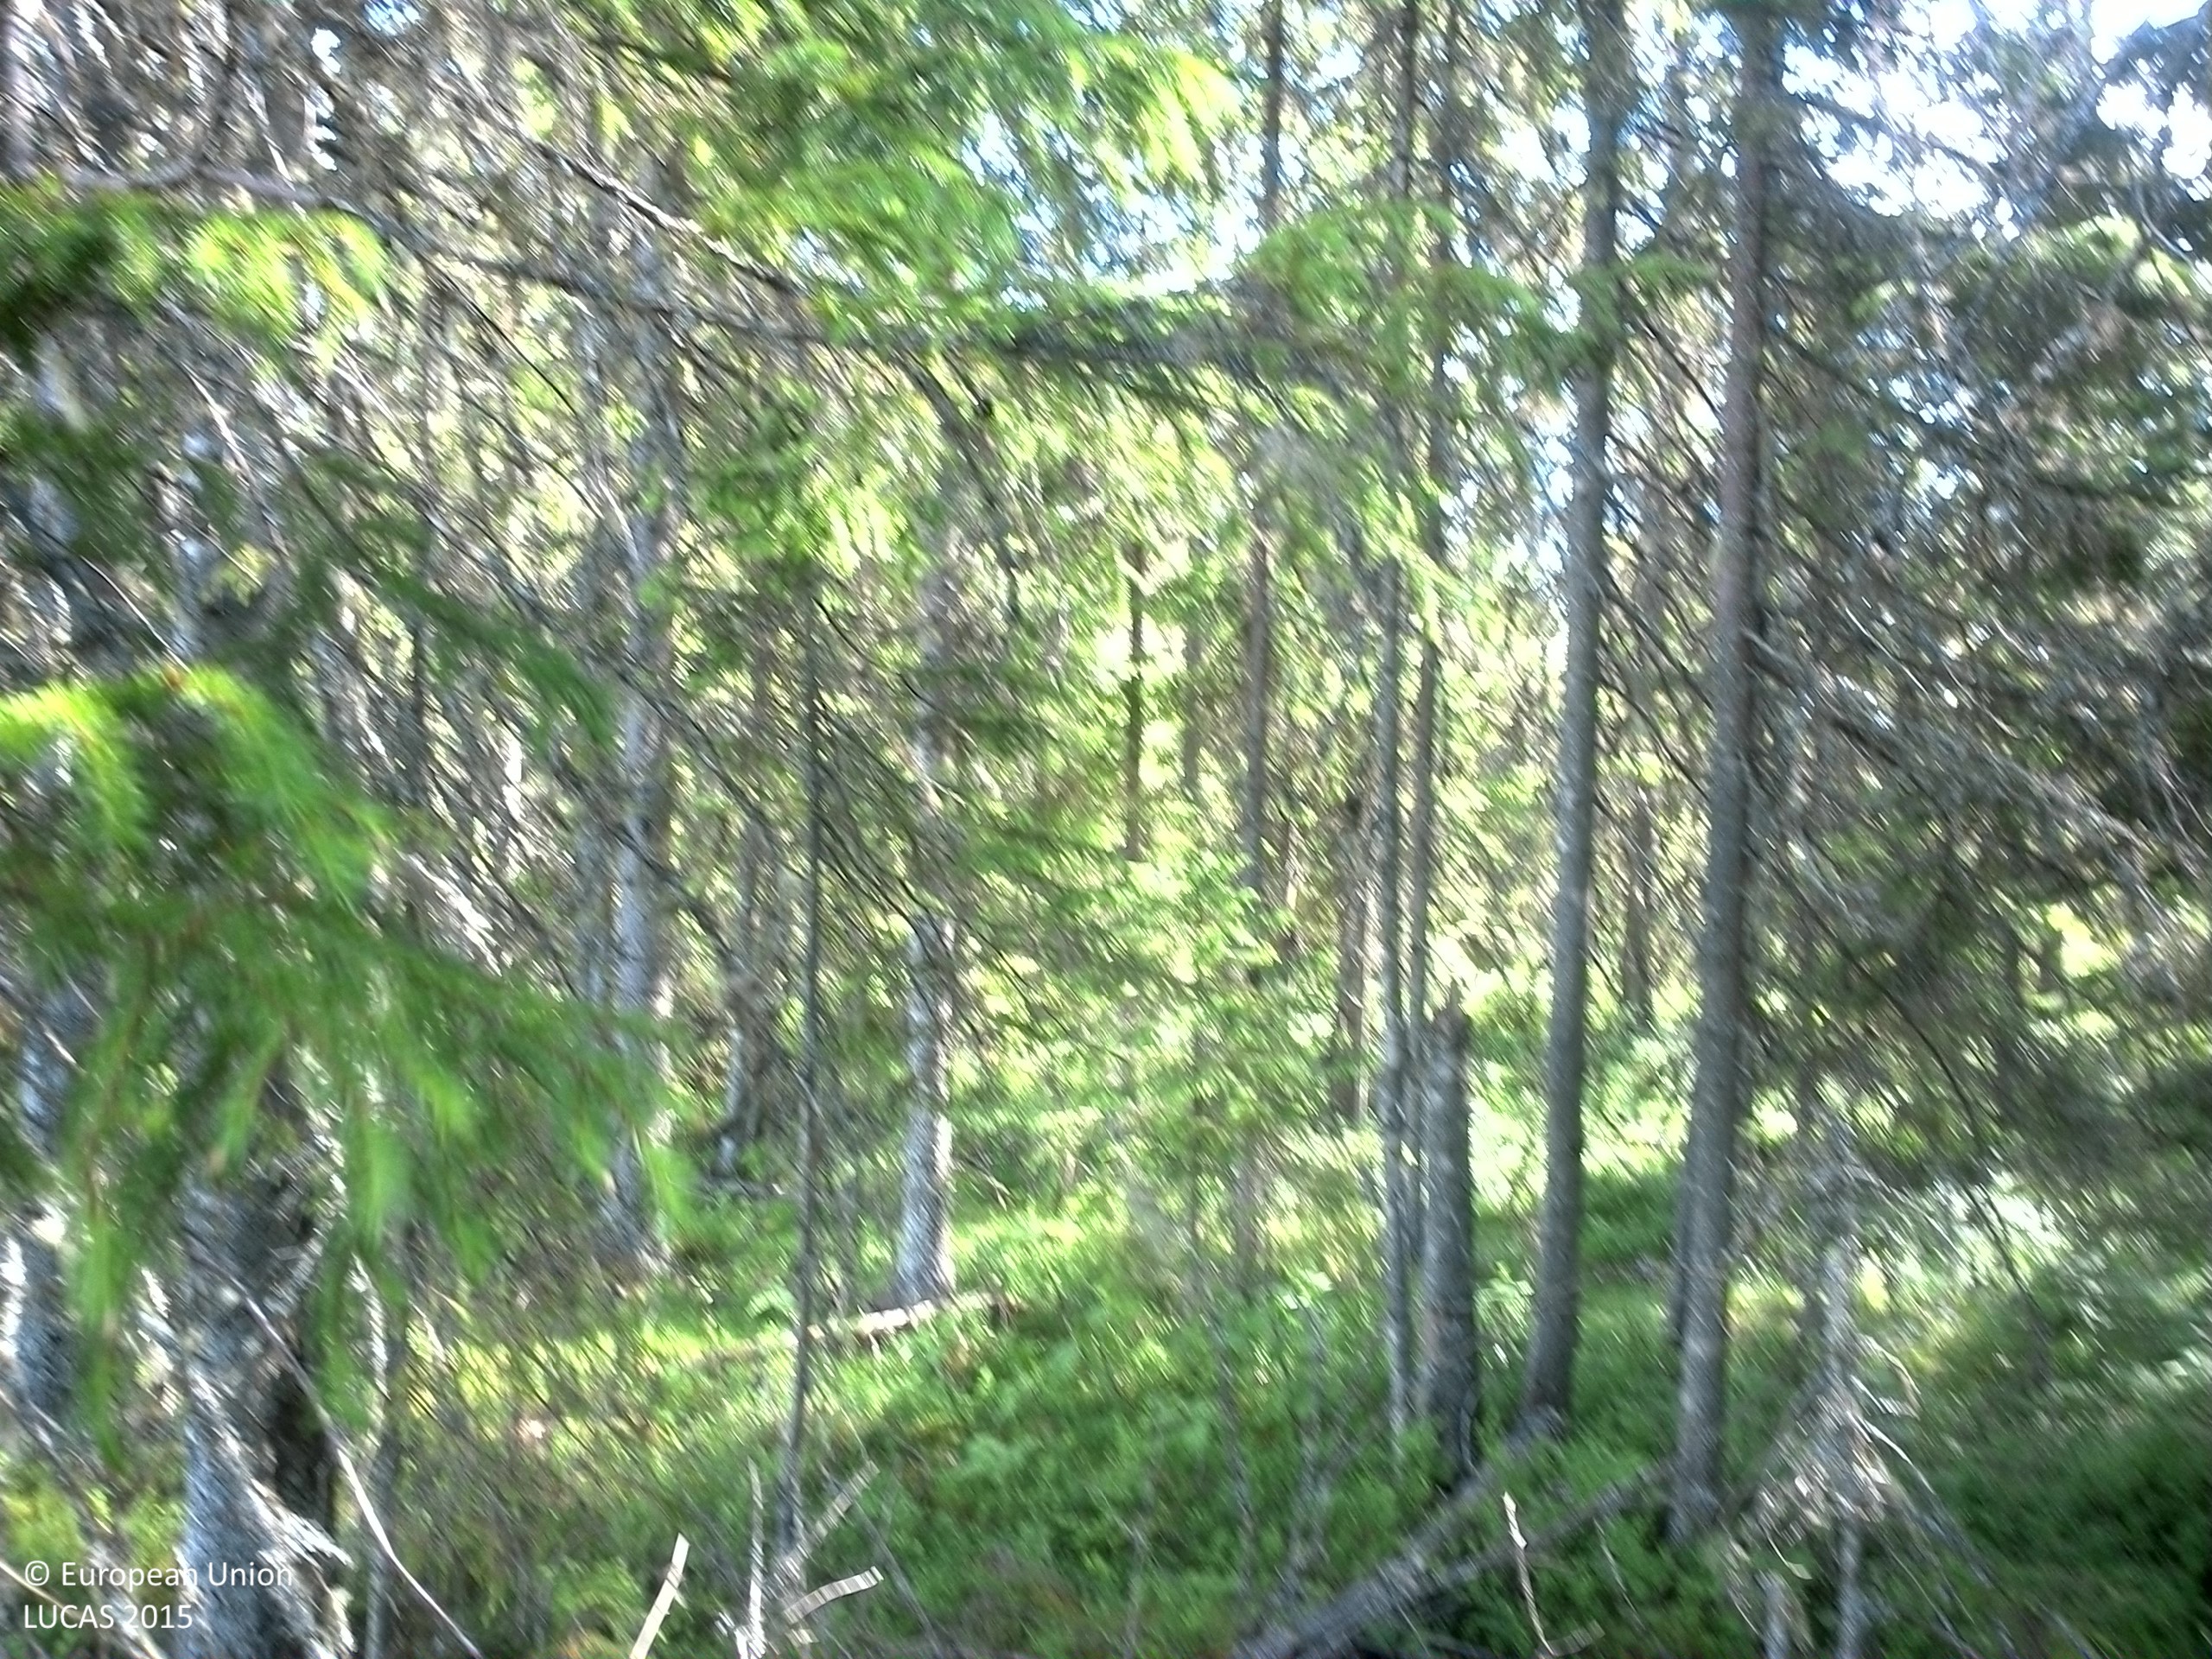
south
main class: Woodland
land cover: Spruce dominated coniferous woodland
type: boreal forest
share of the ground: 50 - 75 %
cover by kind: coniferous forest trees 60 %, shrubs 30 %, broadleaved forest trees 10 %
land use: Forestry
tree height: > 5 m
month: June
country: SE
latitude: 62.8485
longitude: 17.7371
